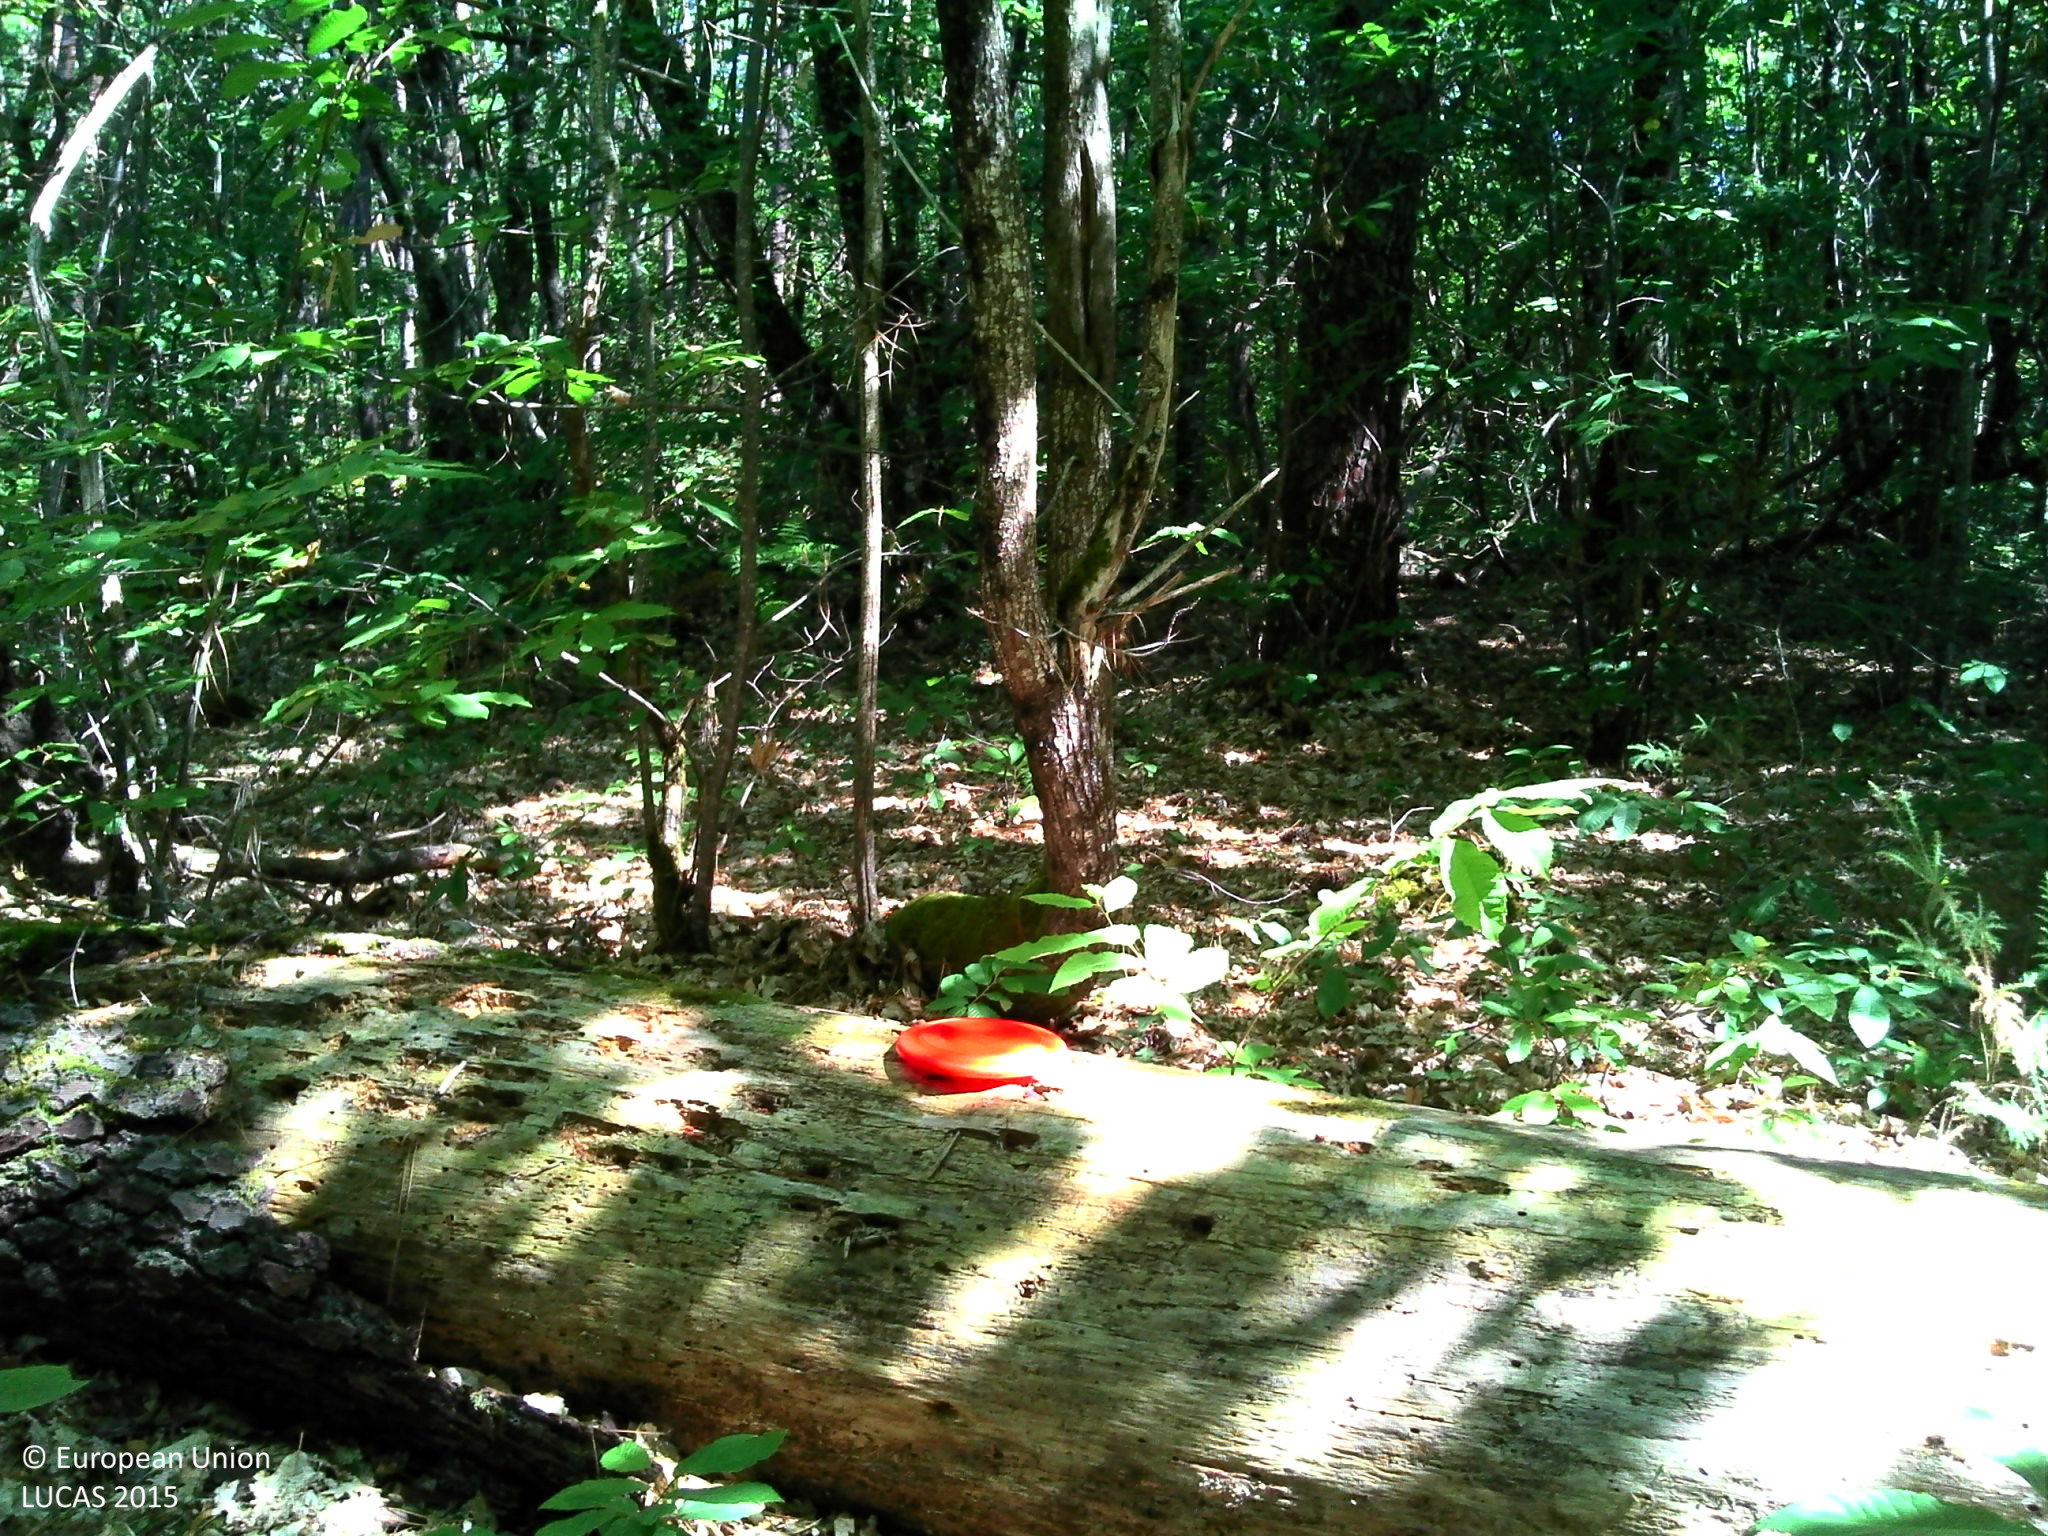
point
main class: Woodland
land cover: Broadleaved woodland
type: acidophilous oak and oak-birch forest
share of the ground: > 75 %
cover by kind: broadleaved forest trees 80 %, herbaceous plants 10 %, shrubs 5 %, lichens and mosses 5 %
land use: Forestry
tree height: > 5 m
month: July
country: FR
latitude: 44.9167
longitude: 0.5530
